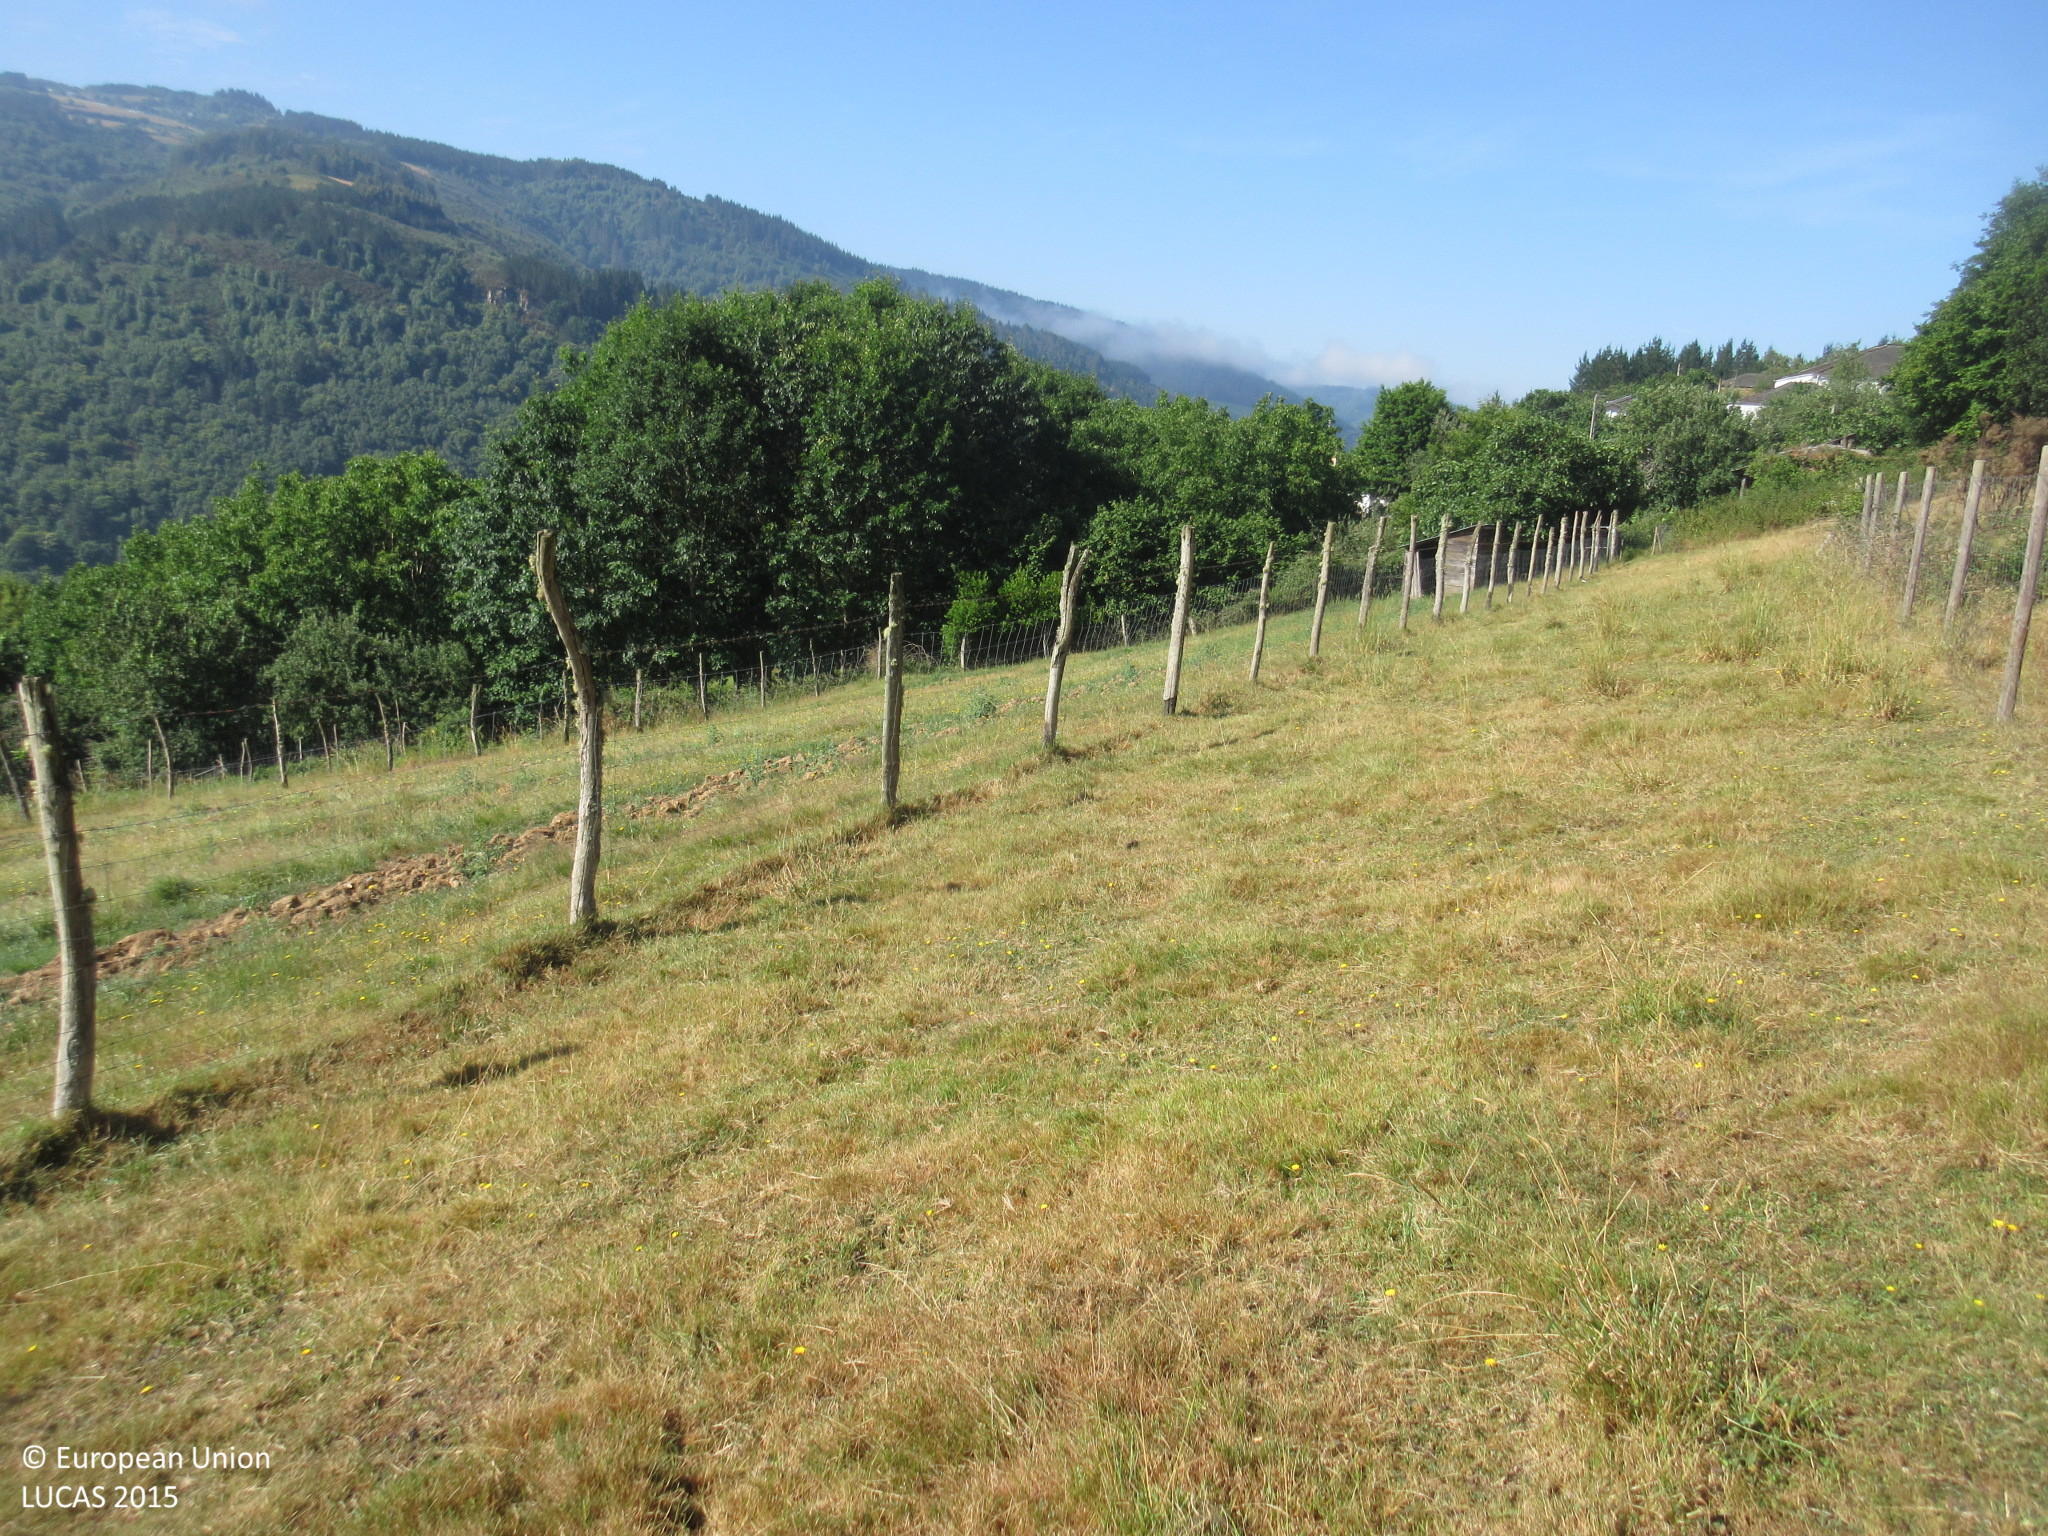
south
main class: Grassland
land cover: Grassland without tree/shrub cover
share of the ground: > 75 %
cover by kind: herbaceous plants 100 %
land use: Agriculture (excluding fallow land and kitchen gardens)
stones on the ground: 10 - 25 %
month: June
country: ES
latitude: 43.0956
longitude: -7.0307
